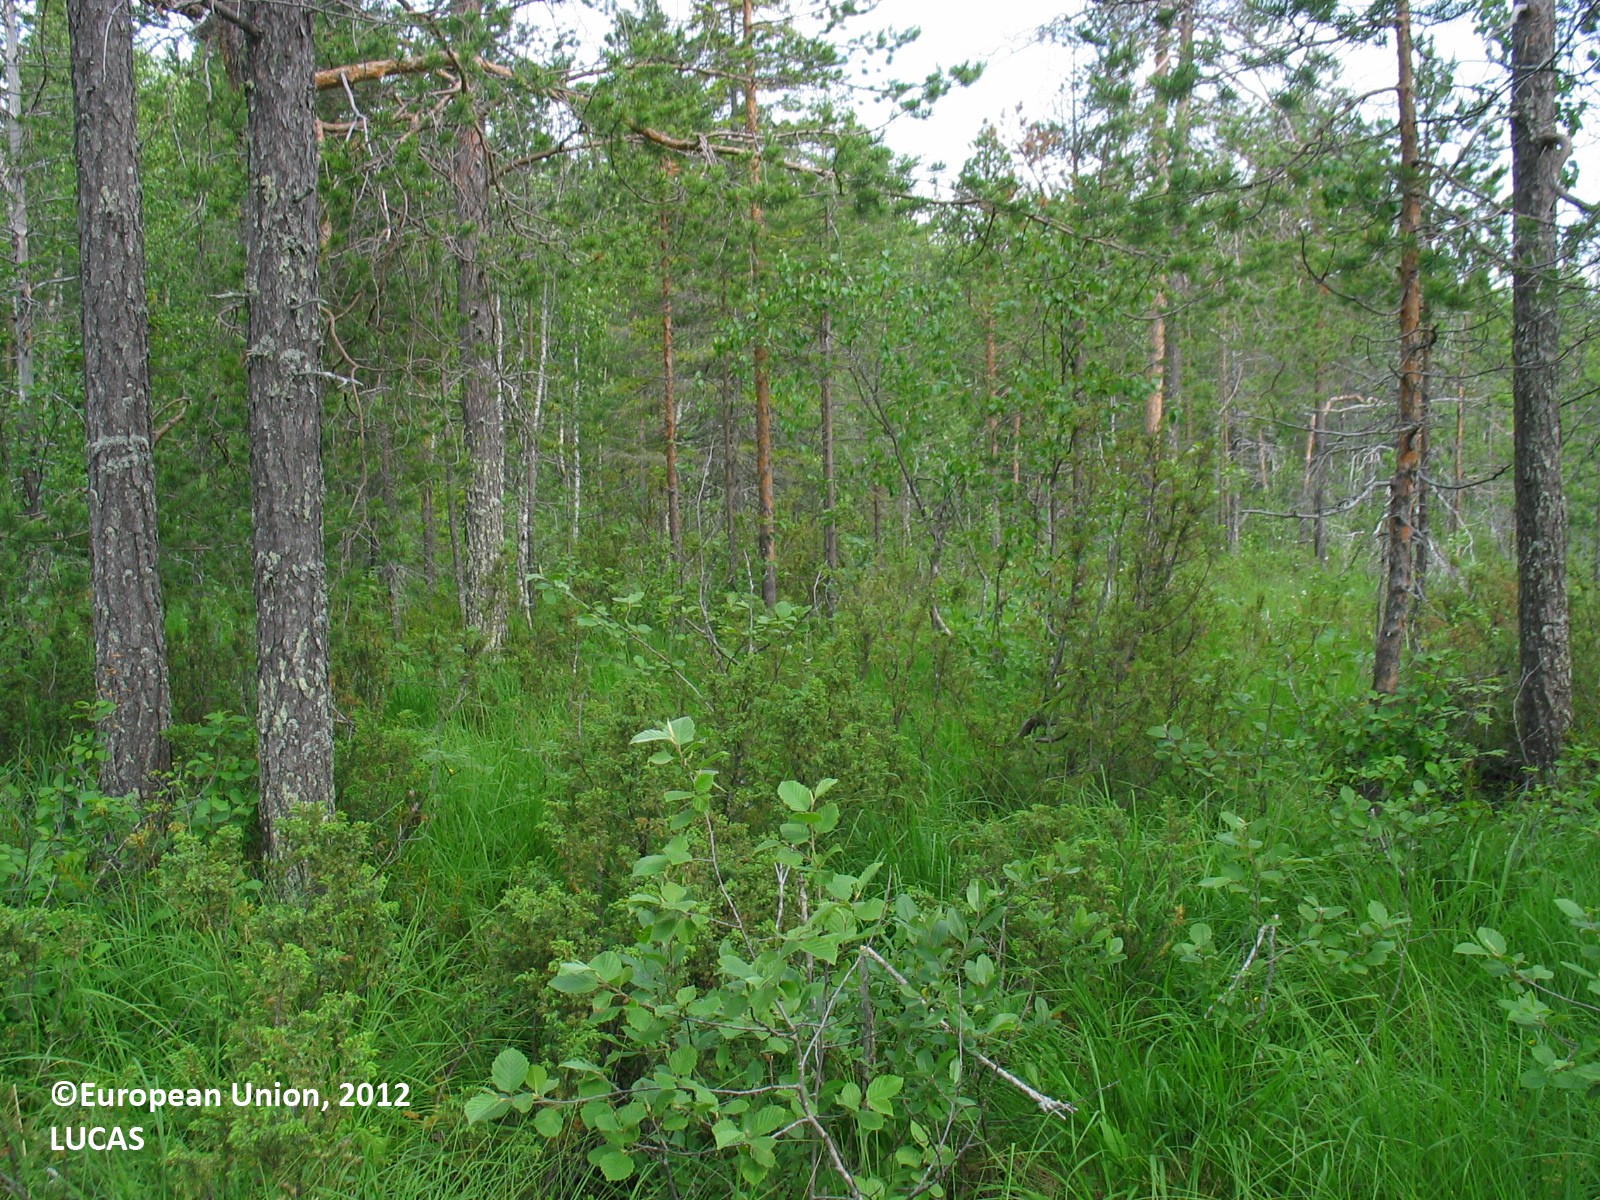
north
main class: Woodland
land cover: Pine dominated coniferous woodland
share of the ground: 25 - 50 %
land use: Semi-natural and natural areas not in use
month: July
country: FI
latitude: 65.9761
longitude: 25.1424
